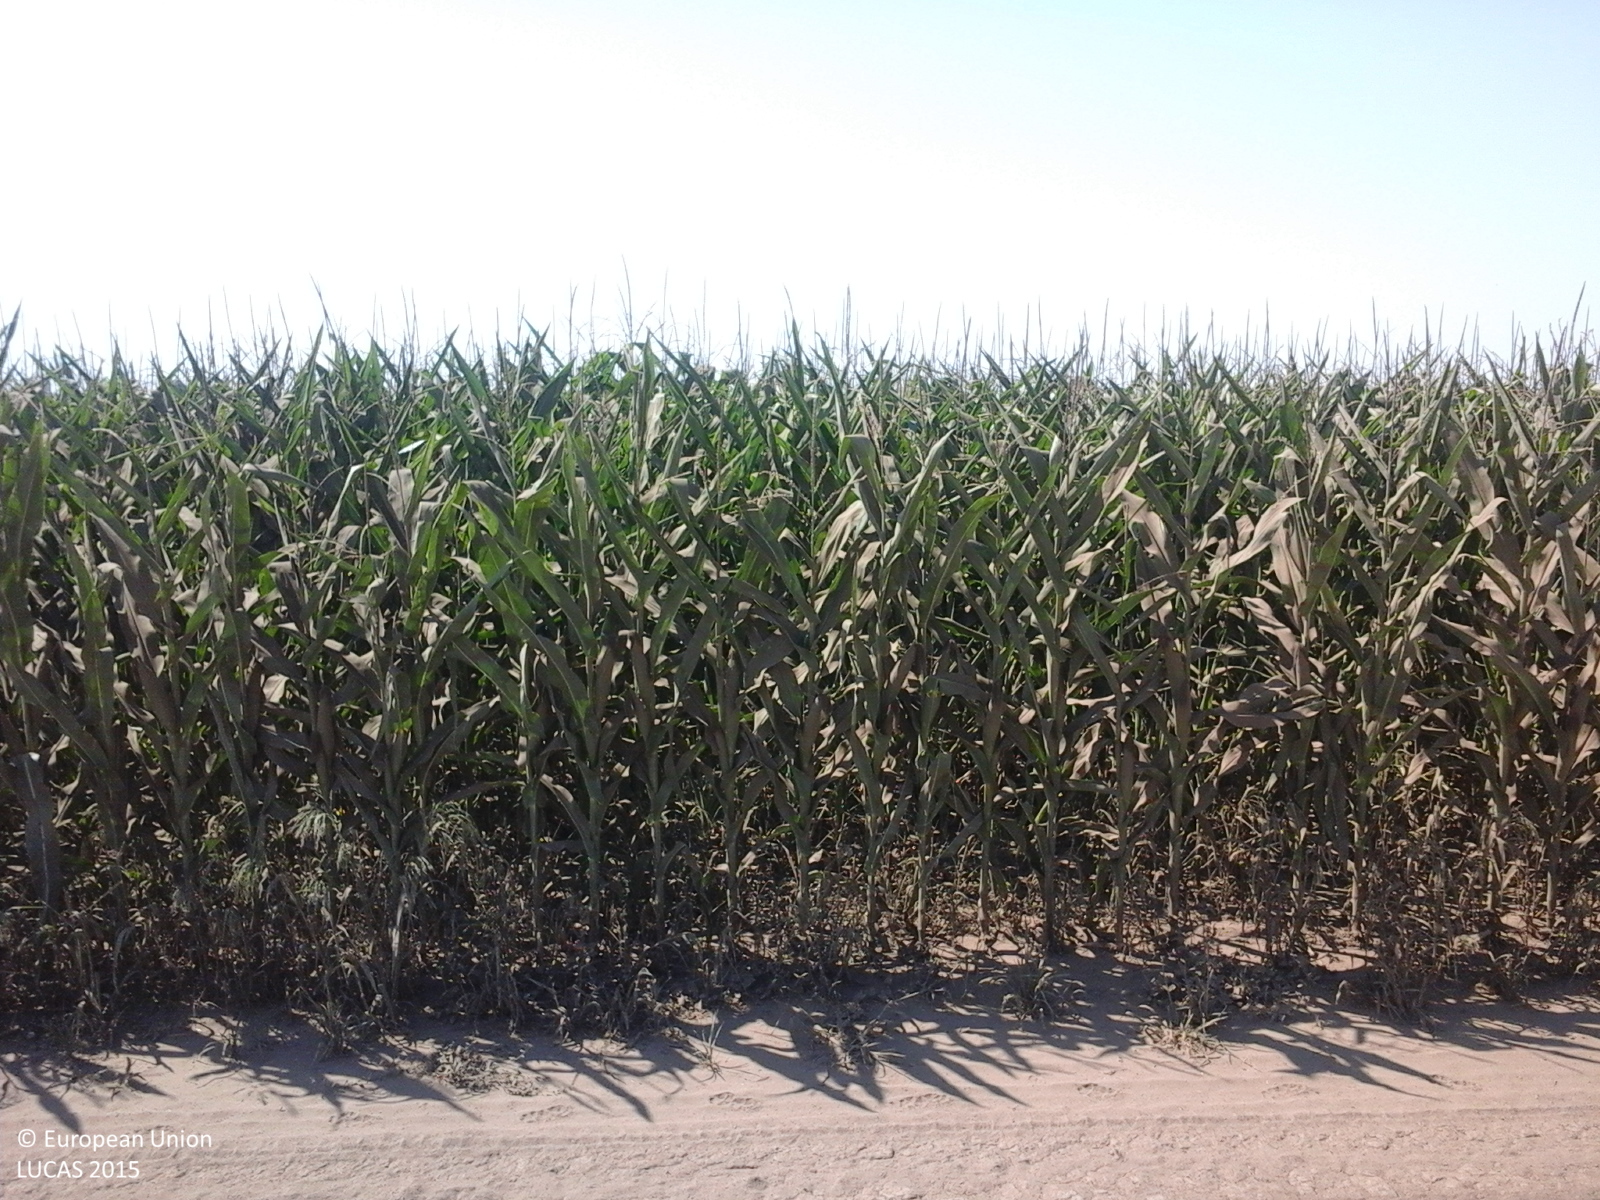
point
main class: Cropland
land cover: Maize
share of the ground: > 75 %
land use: Agriculture (excluding fallow land and kitchen gardens)
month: July
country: RO
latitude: 45.0218
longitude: 27.2875
